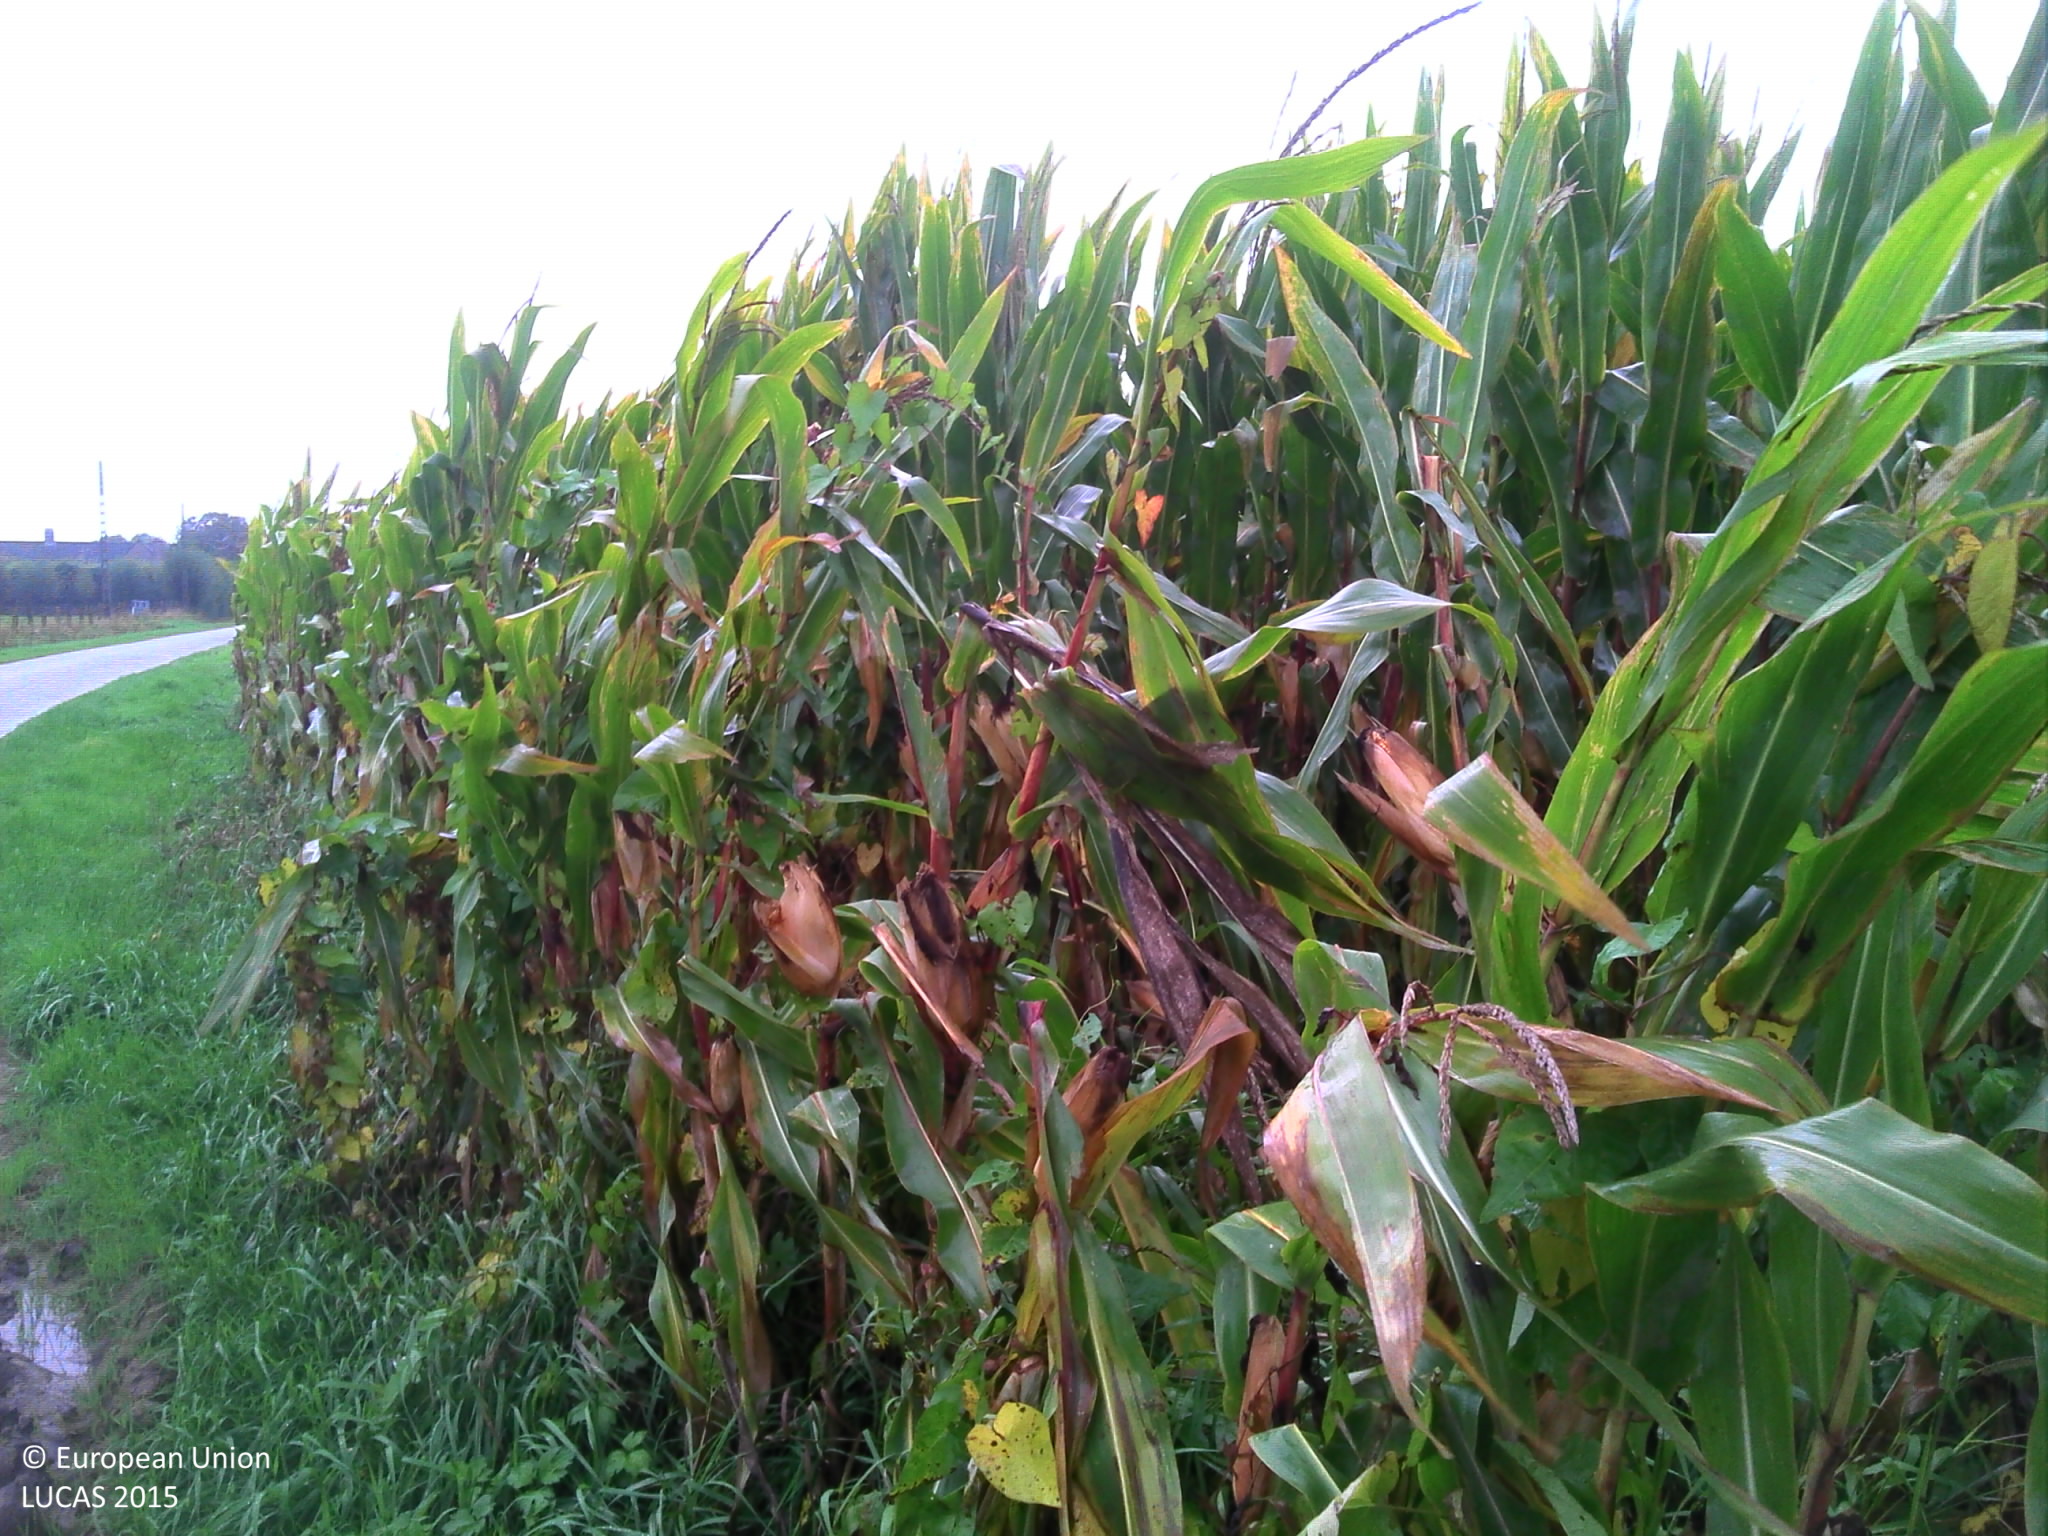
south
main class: Cropland
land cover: Maize
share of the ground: > 75 %
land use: Agriculture (excluding fallow land and kitchen gardens)
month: October
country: BE
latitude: 50.9242
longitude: 2.9761
